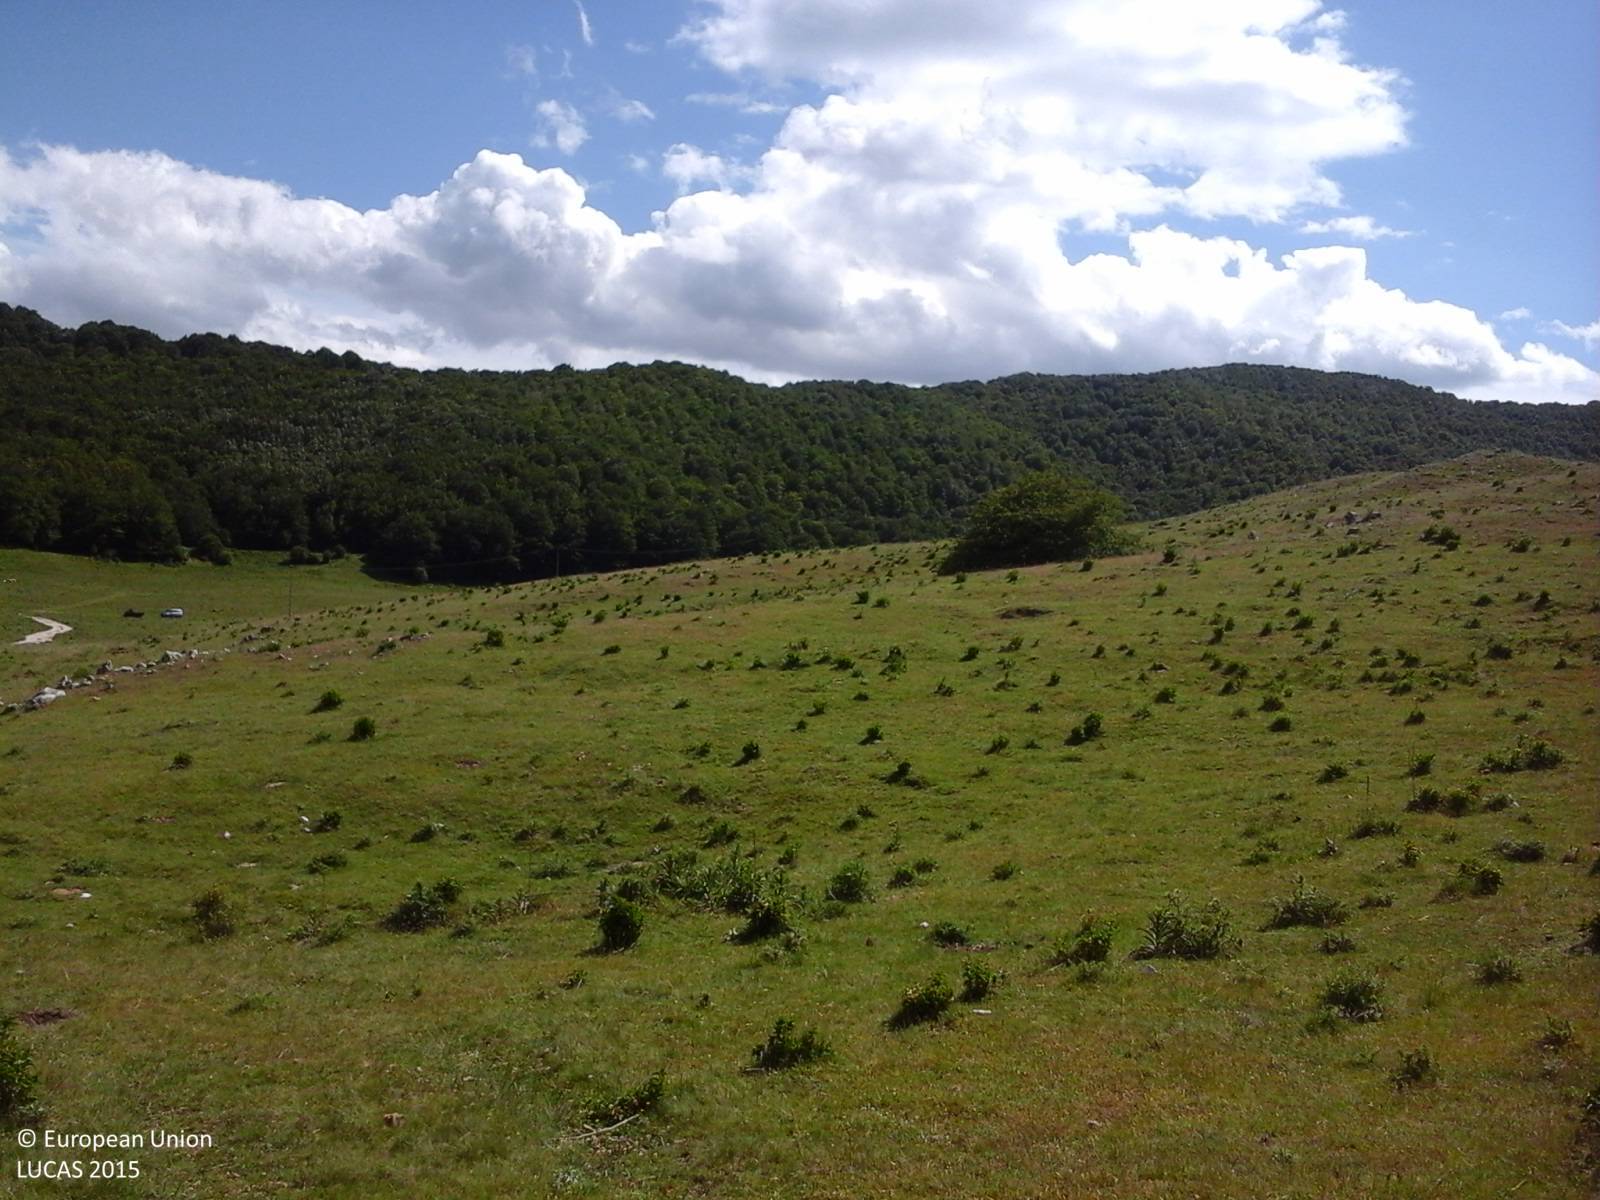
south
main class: Grassland
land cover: Grassland without tree/shrub cover
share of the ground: > 75 %
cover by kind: herbaceous plants 90 %, unconsolidated bare surface 10 %
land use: Agriculture (excluding fallow land and kitchen gardens)
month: June
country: IT
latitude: 41.4207
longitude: 14.3511
